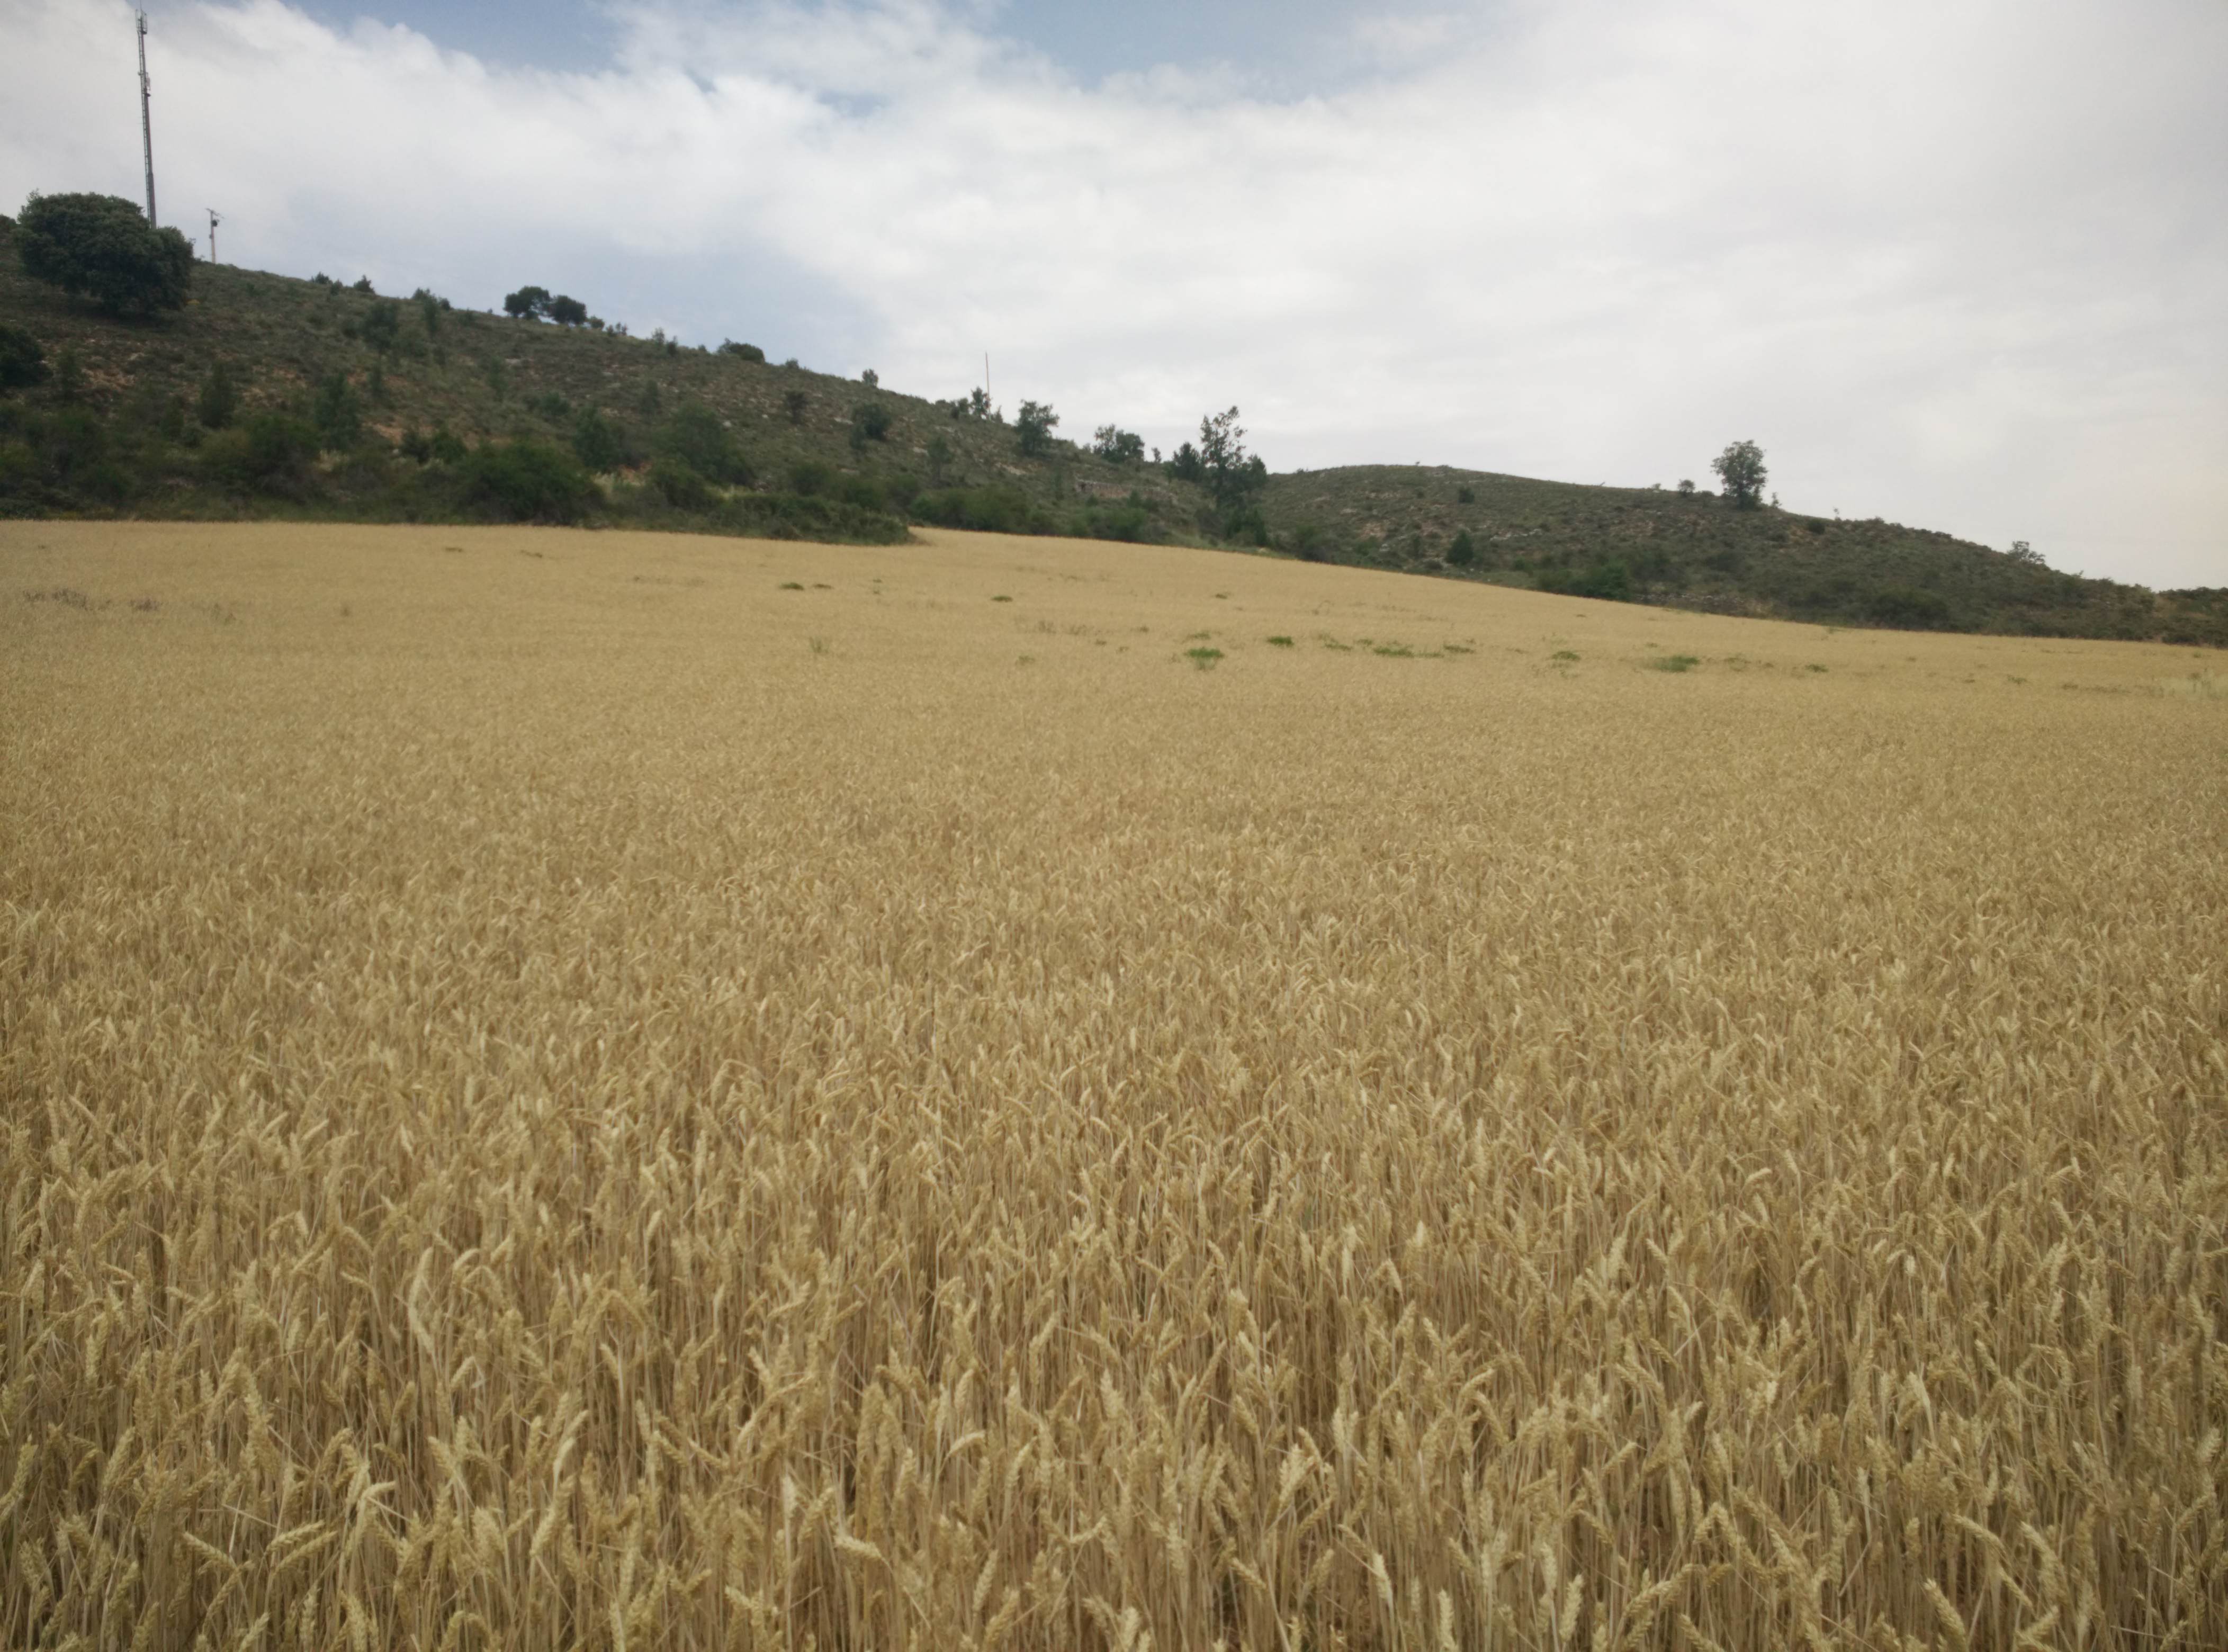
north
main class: Cropland
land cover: Common wheat
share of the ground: > 75 %
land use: Agriculture (excluding fallow land and kitchen gardens)
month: July
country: ES
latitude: 40.9724
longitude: -2.1353
